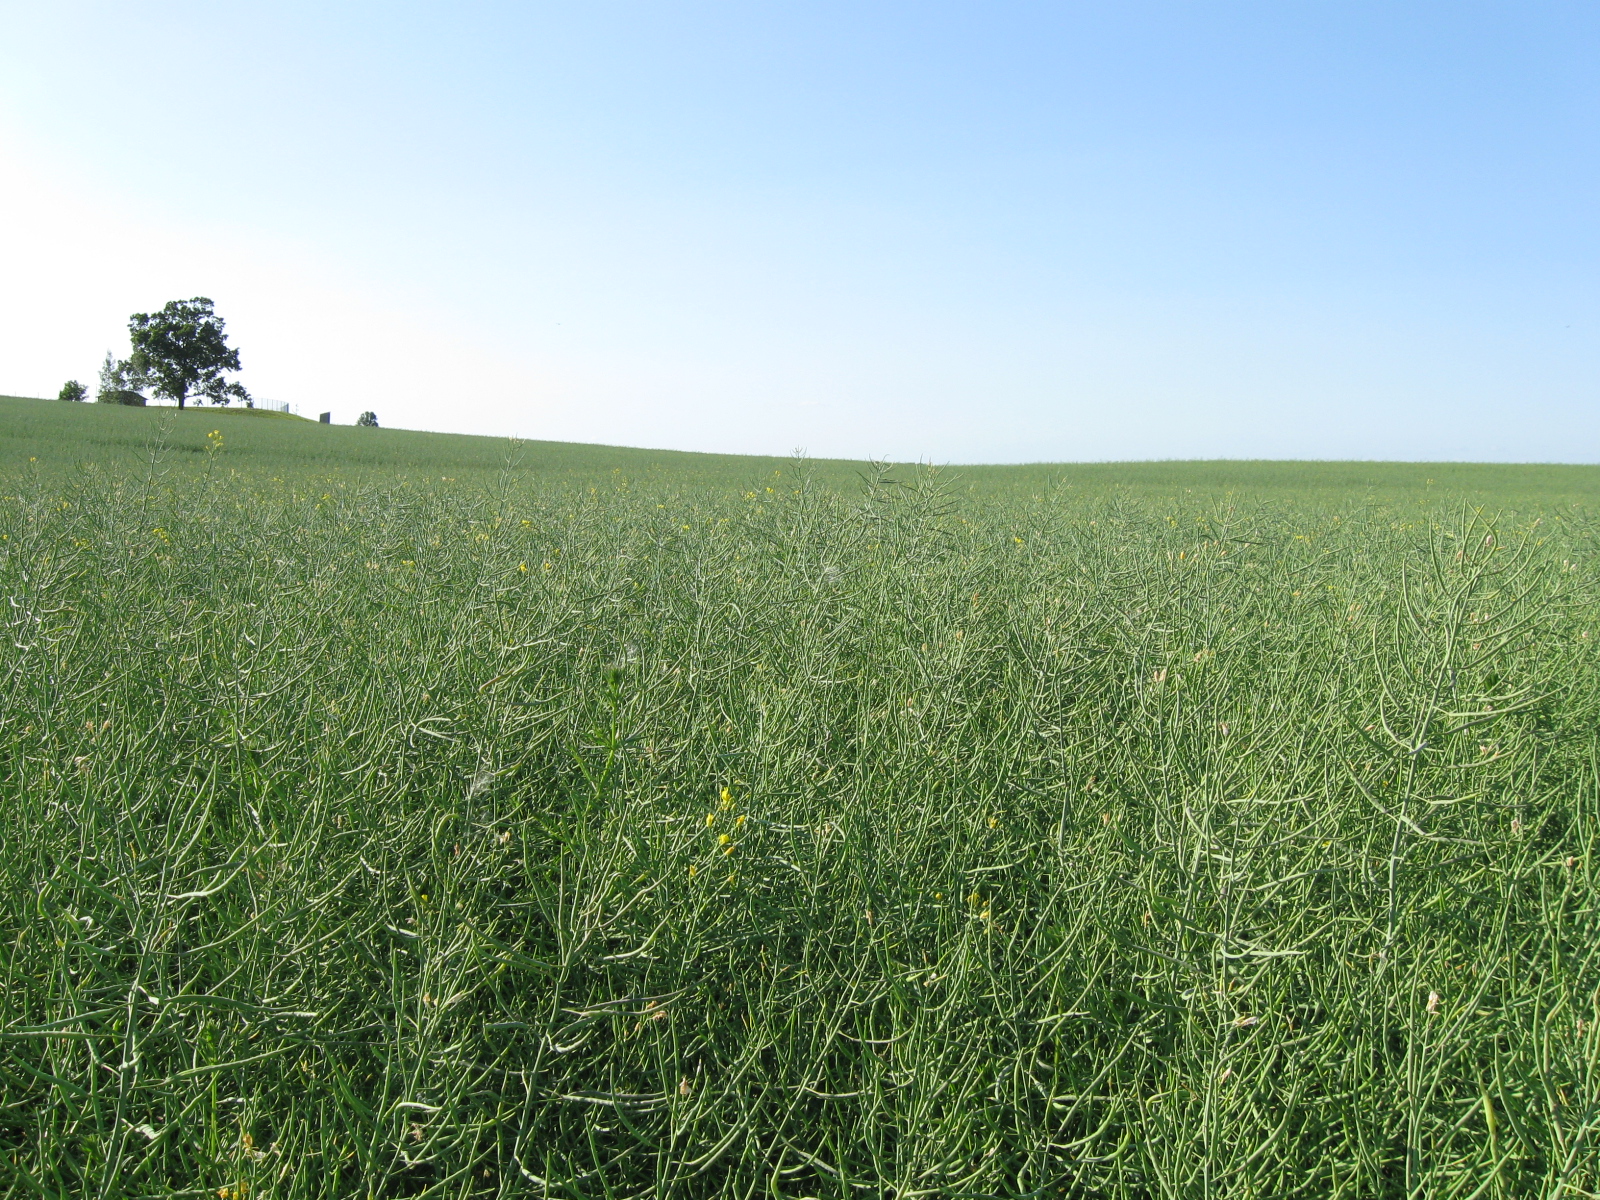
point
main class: Cropland
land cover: Rape and turnip rape
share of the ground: > 75 %
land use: Agriculture (excluding fallow land and kitchen gardens)
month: June
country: LT
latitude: 54.4333
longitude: 23.7930
